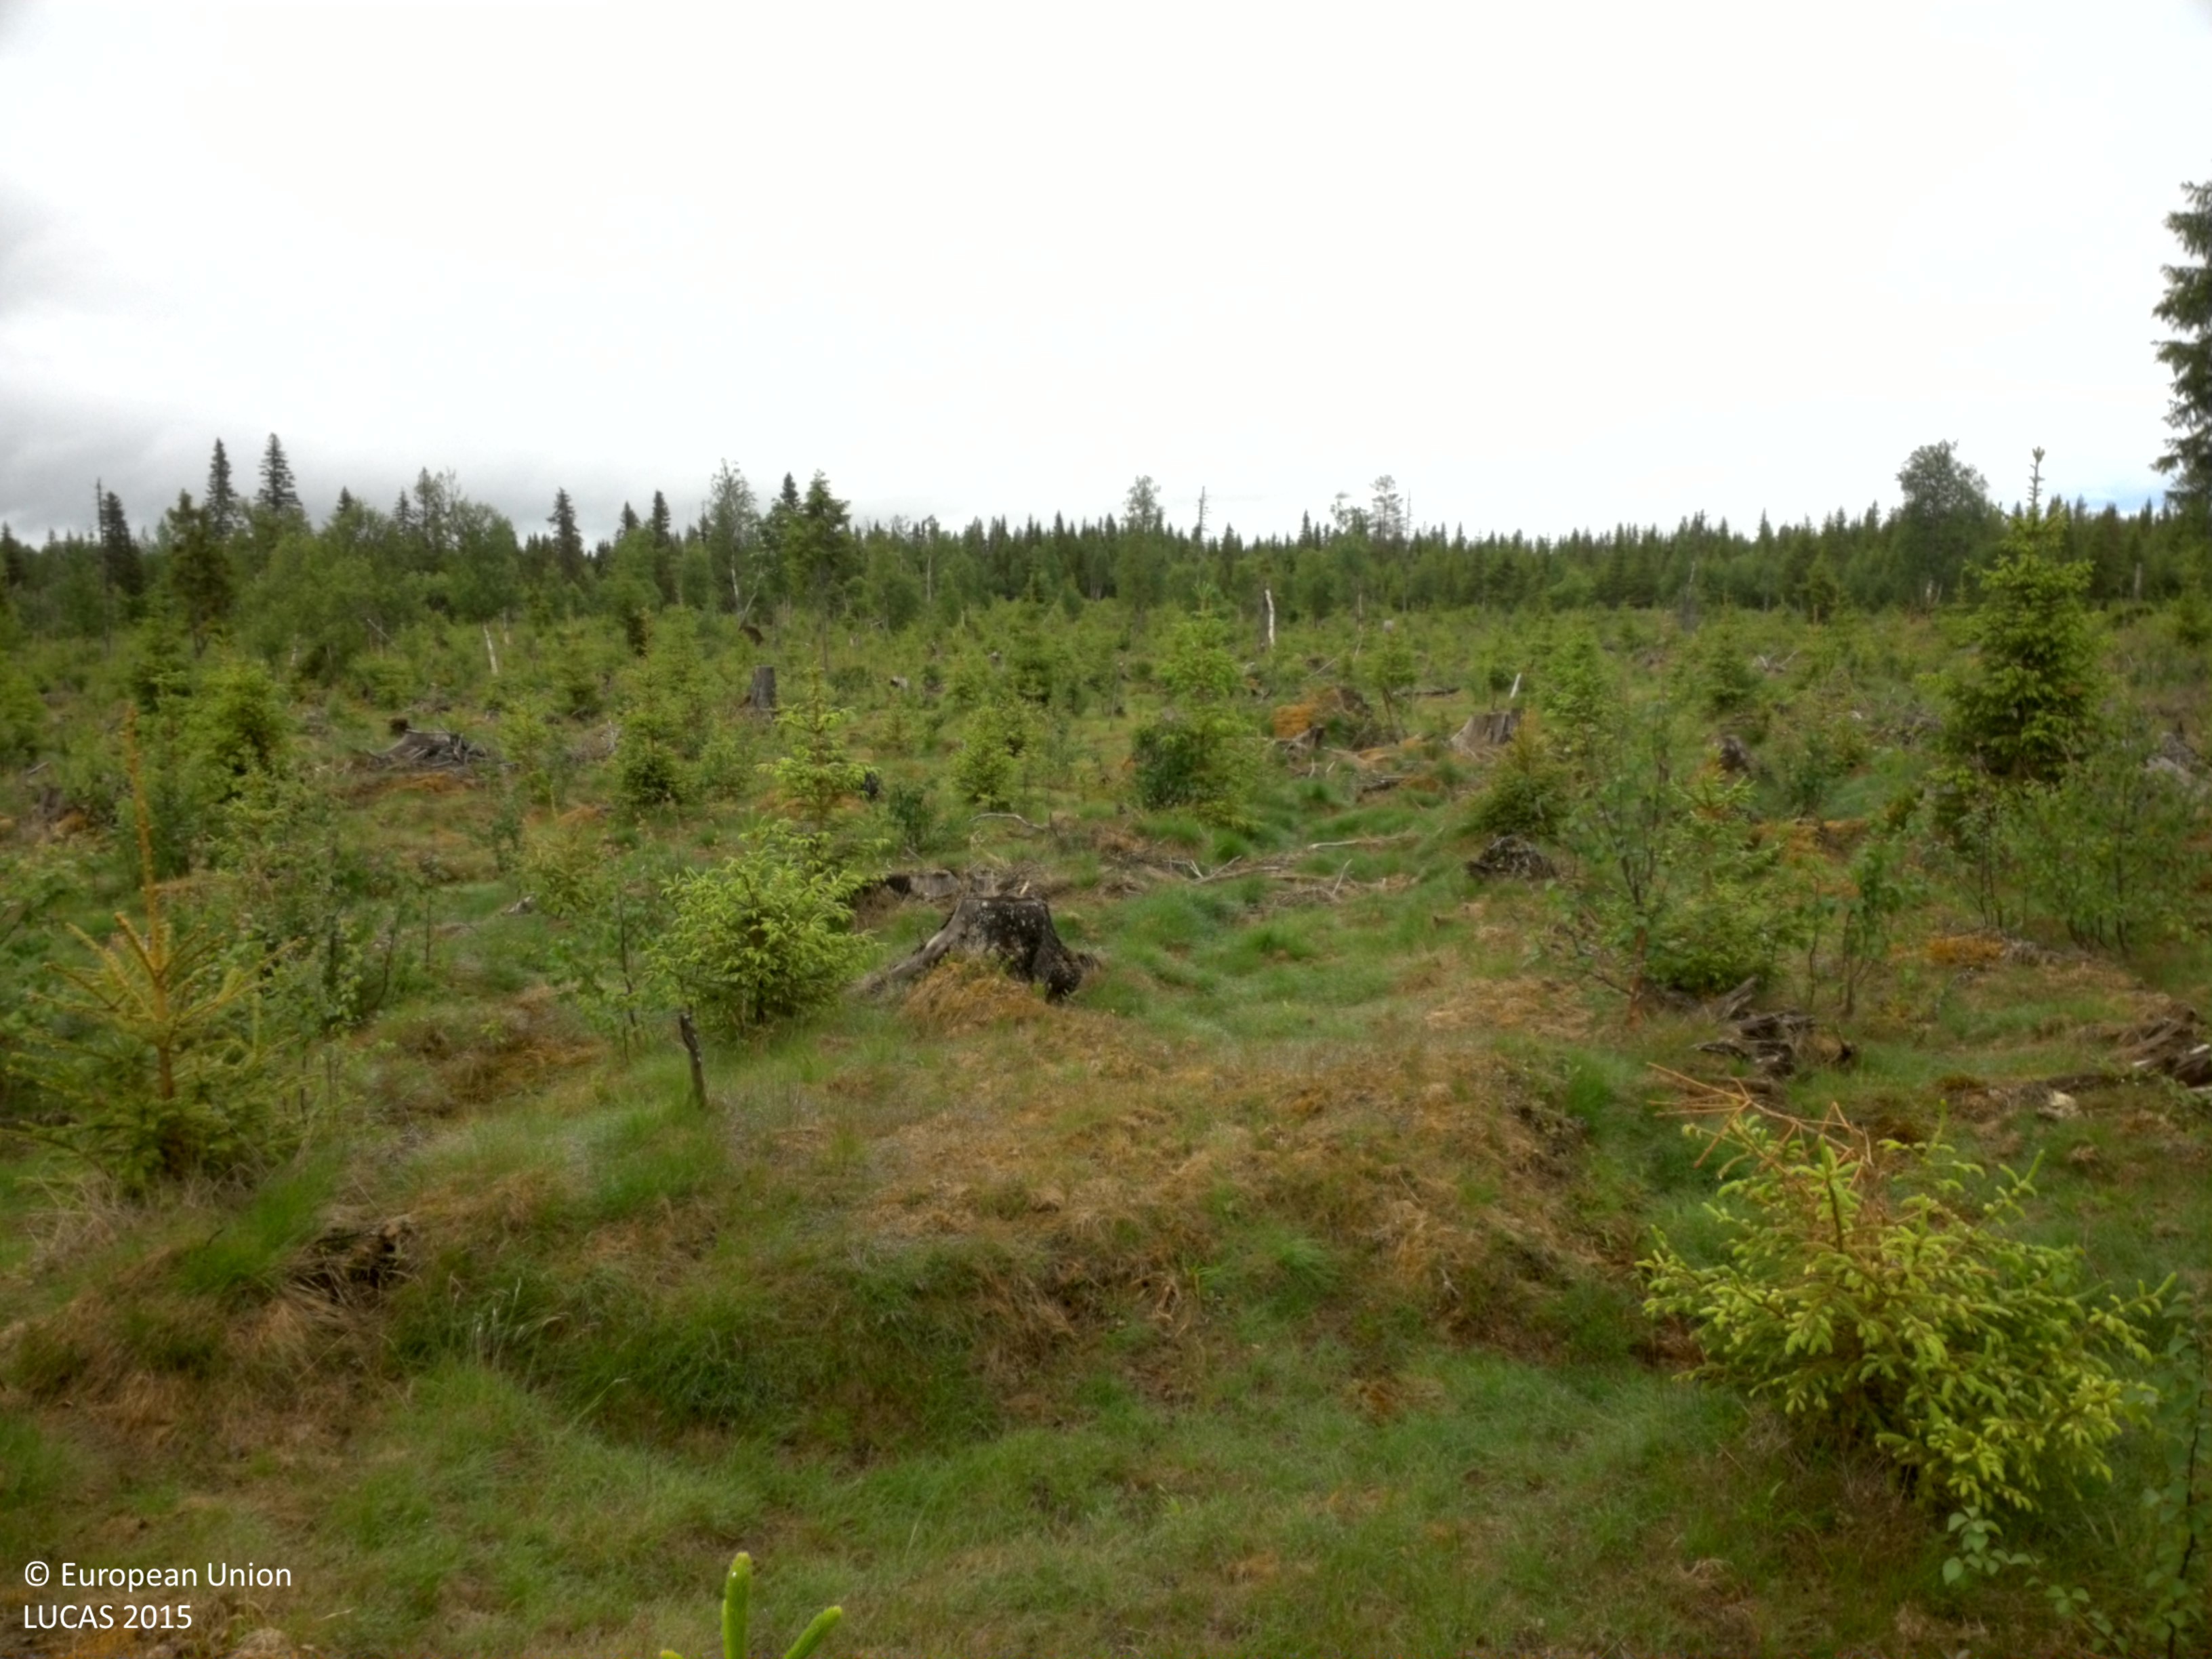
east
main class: Woodland
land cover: Spruce dominated mixed woodland
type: boreal forest
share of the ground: 10 - 25 %
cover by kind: coniferous forest trees 40 %, herbaceous plants 40 %, broadleaved forest trees 20 %
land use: Forestry
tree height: < 5 m
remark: Clear cut
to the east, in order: Spruce dominated mixed woodland; Other mixed woodland; Spruce dominated mixed woodland; Spruce dominated coniferous woodland; Peatbogs; Inland marshes; Inland fresh water bodies; Inland marshes
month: July
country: SE
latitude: 64.4280
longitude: 18.0869
